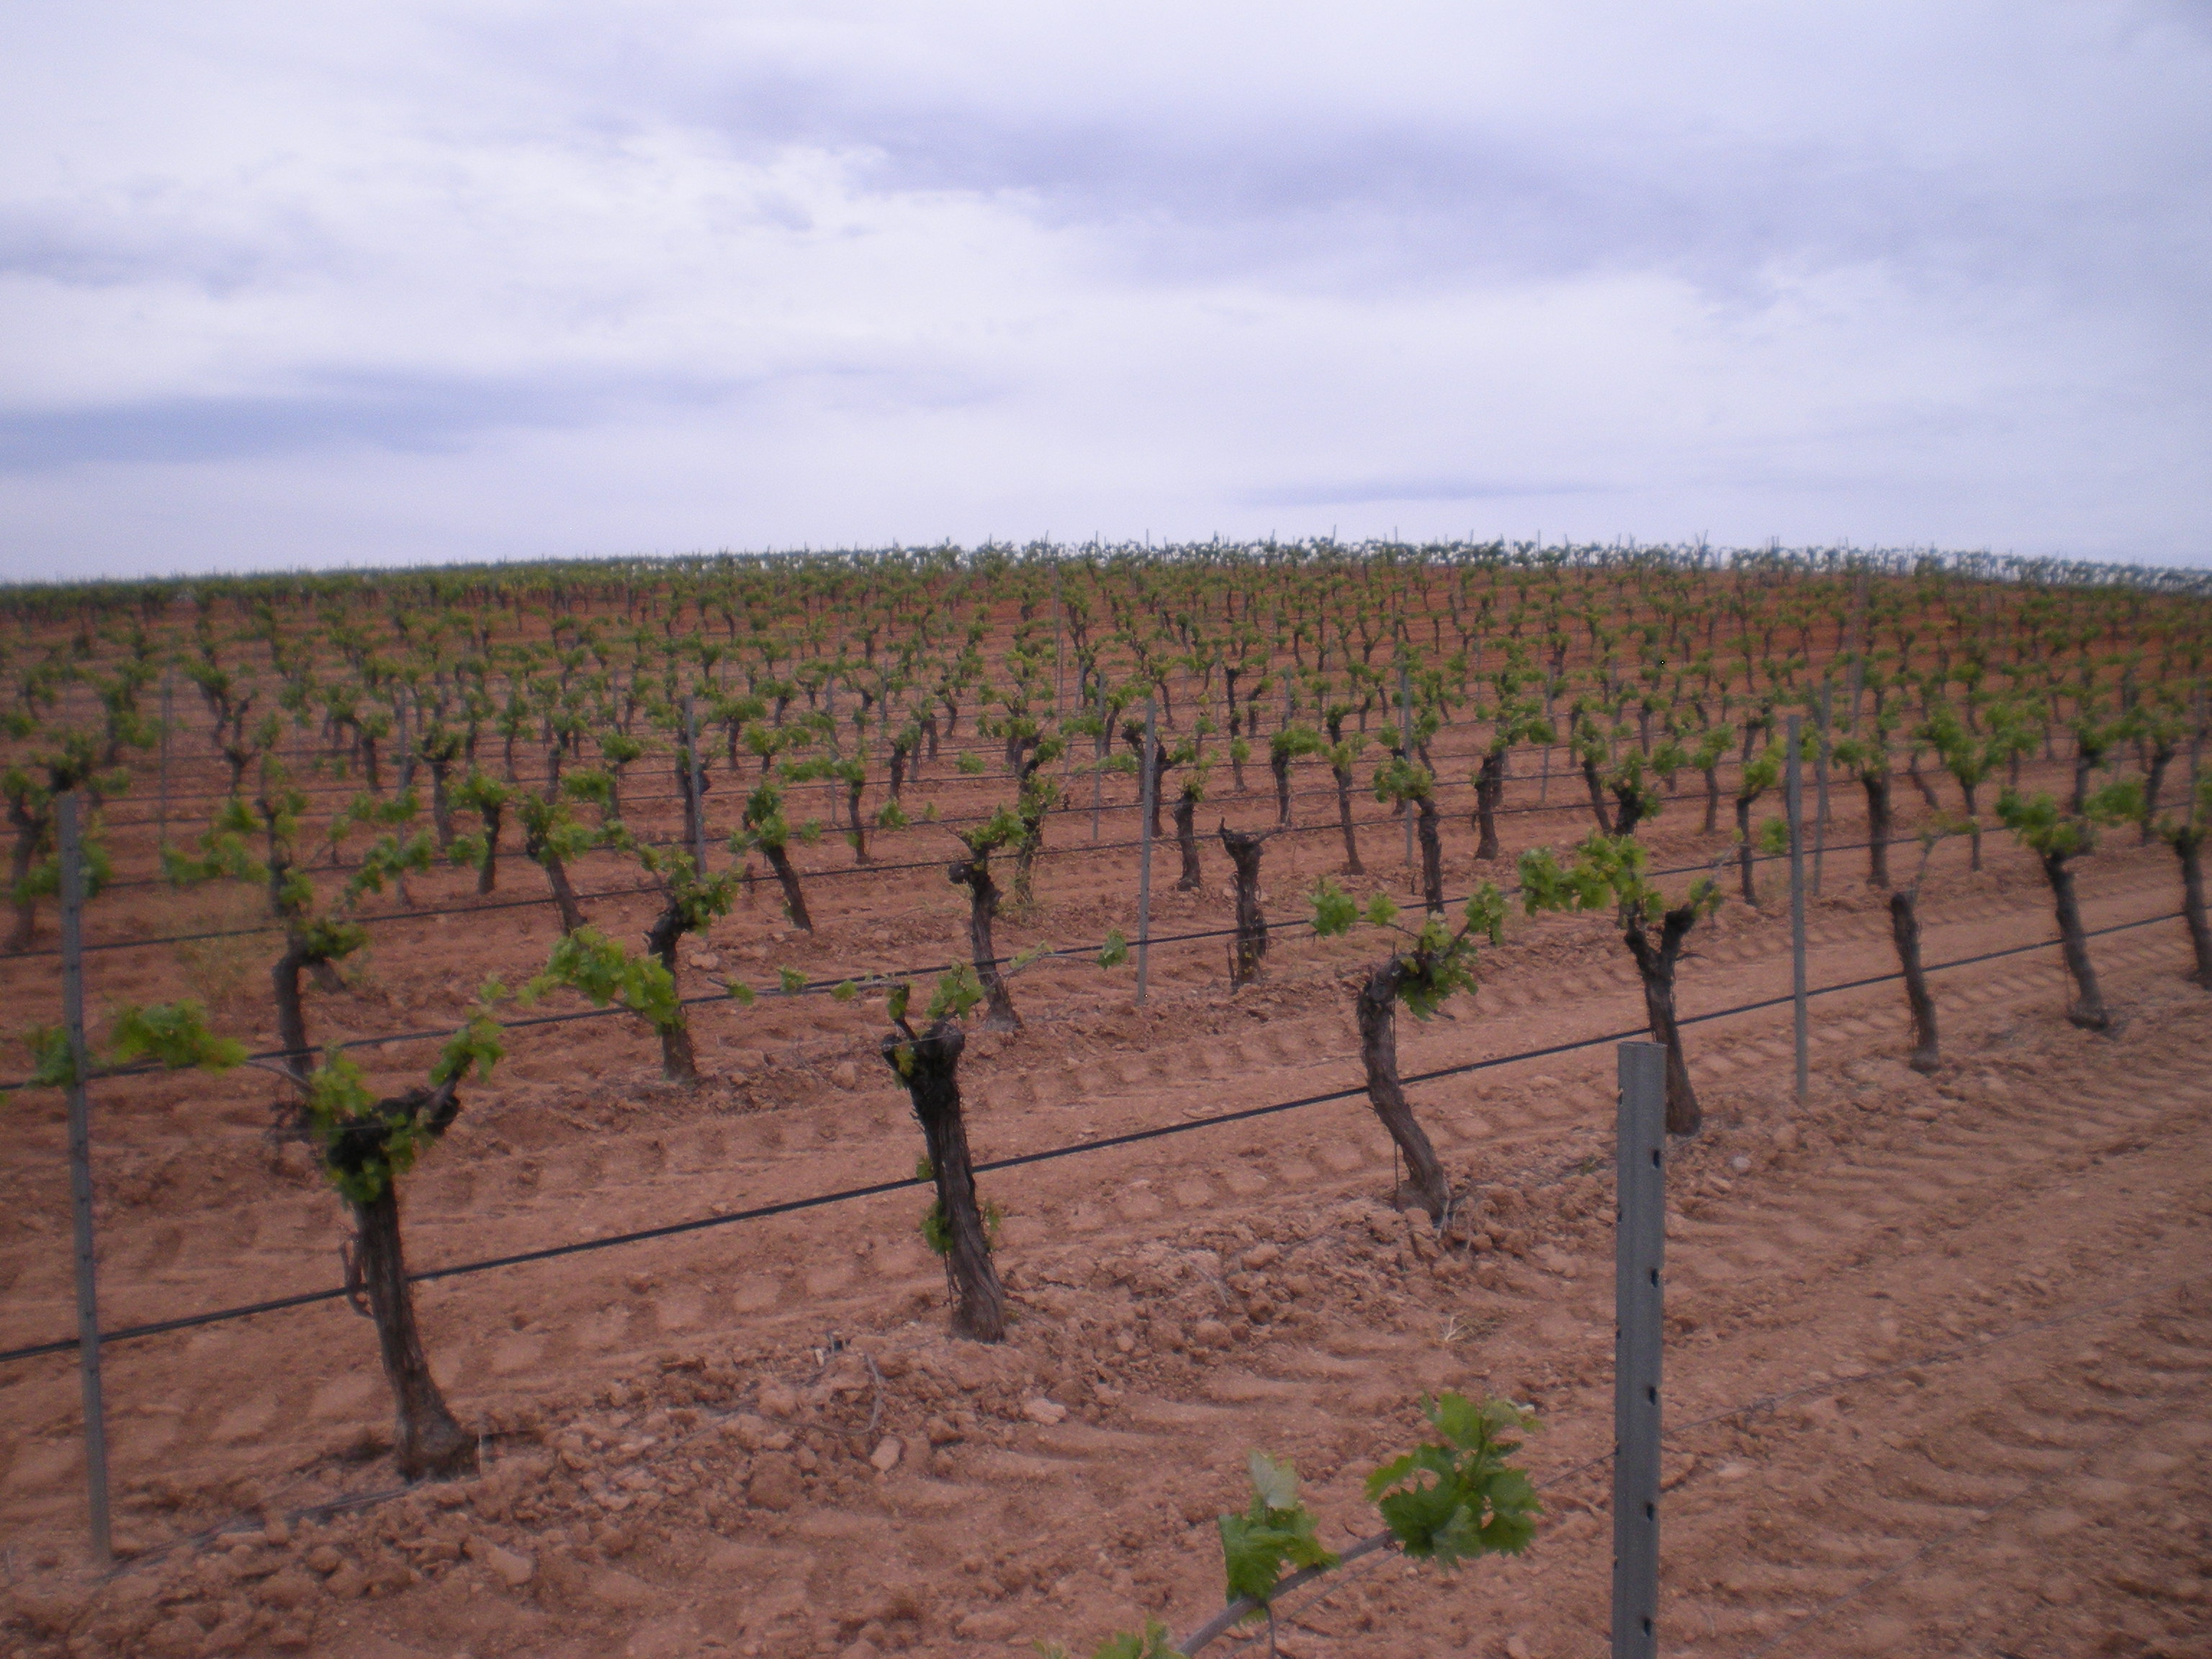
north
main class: Cropland
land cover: Vineyards
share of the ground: < 10 %
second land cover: Other bare soil
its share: > 75 %
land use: Agriculture (excluding fallow land and kitchen gardens)
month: May
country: ES
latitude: 38.7329
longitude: -3.1800
